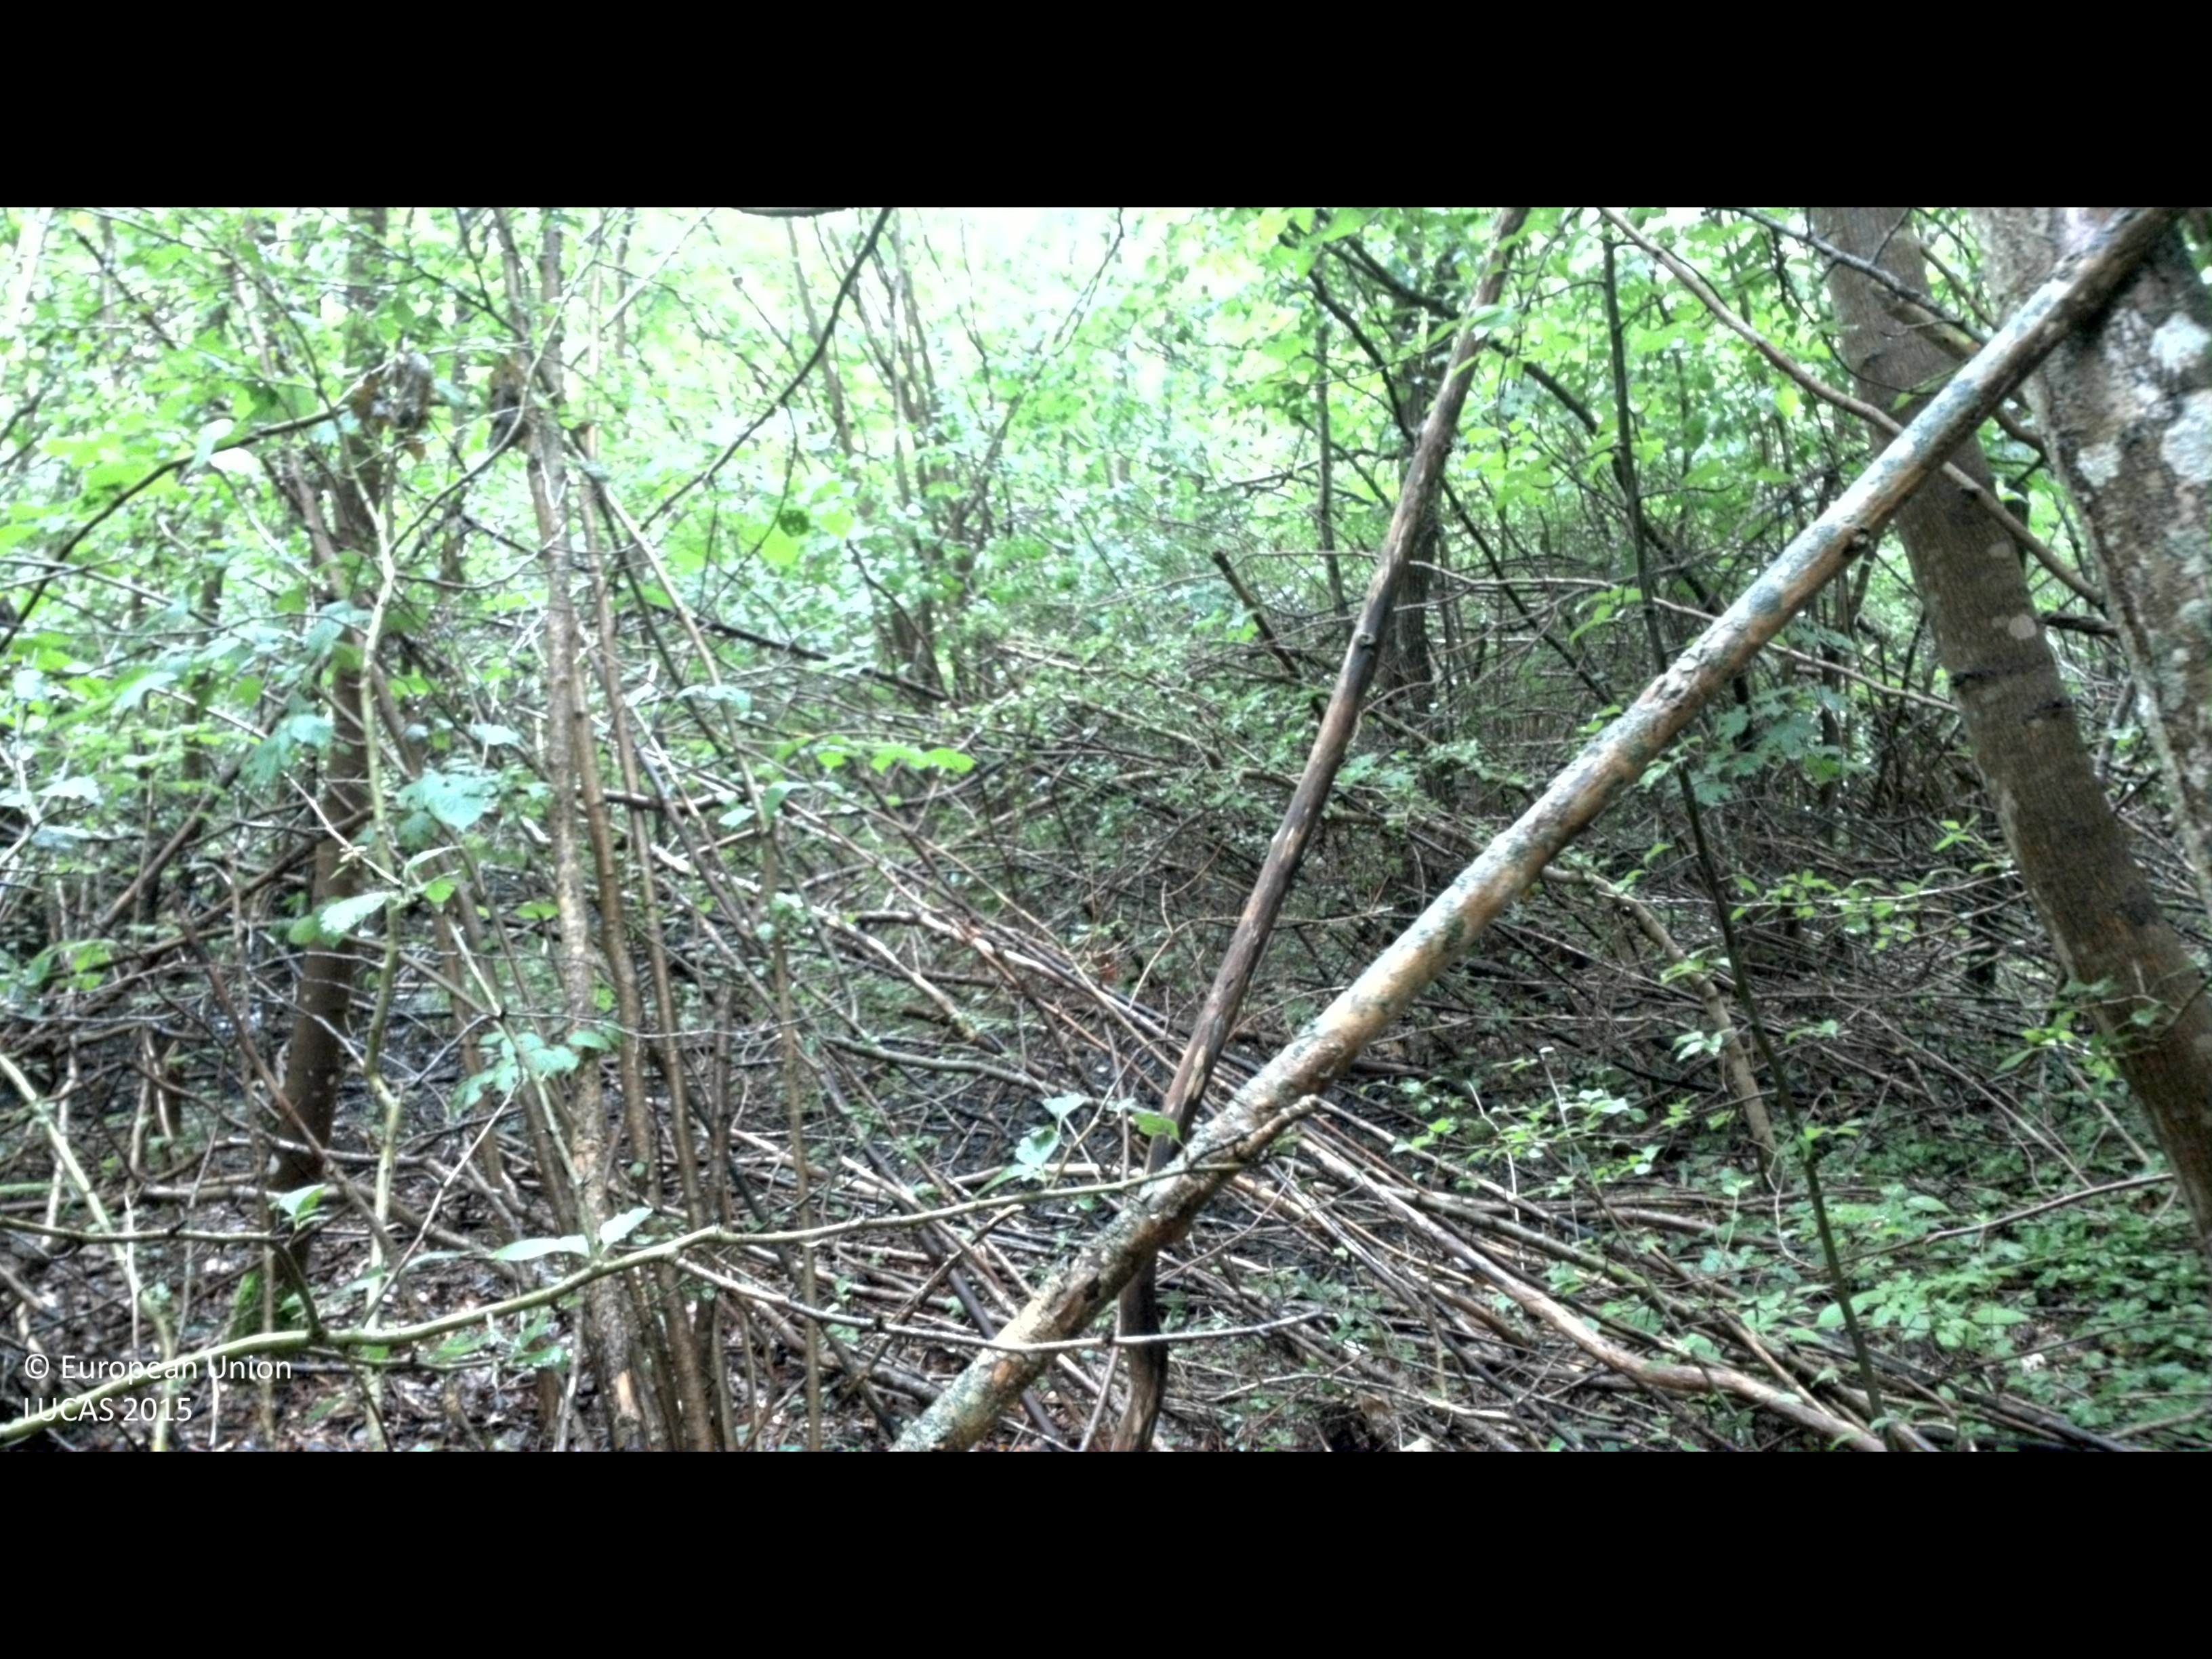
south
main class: Woodland
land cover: Broadleaved woodland
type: mesophytic deciduous forest
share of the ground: 50 - 75 %
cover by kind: broadleaved forest trees 70 %, shrubs 30 %
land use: Semi-natural and natural areas not in use
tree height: > 5 m
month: July
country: SE
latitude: 56.6166
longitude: 16.5361
